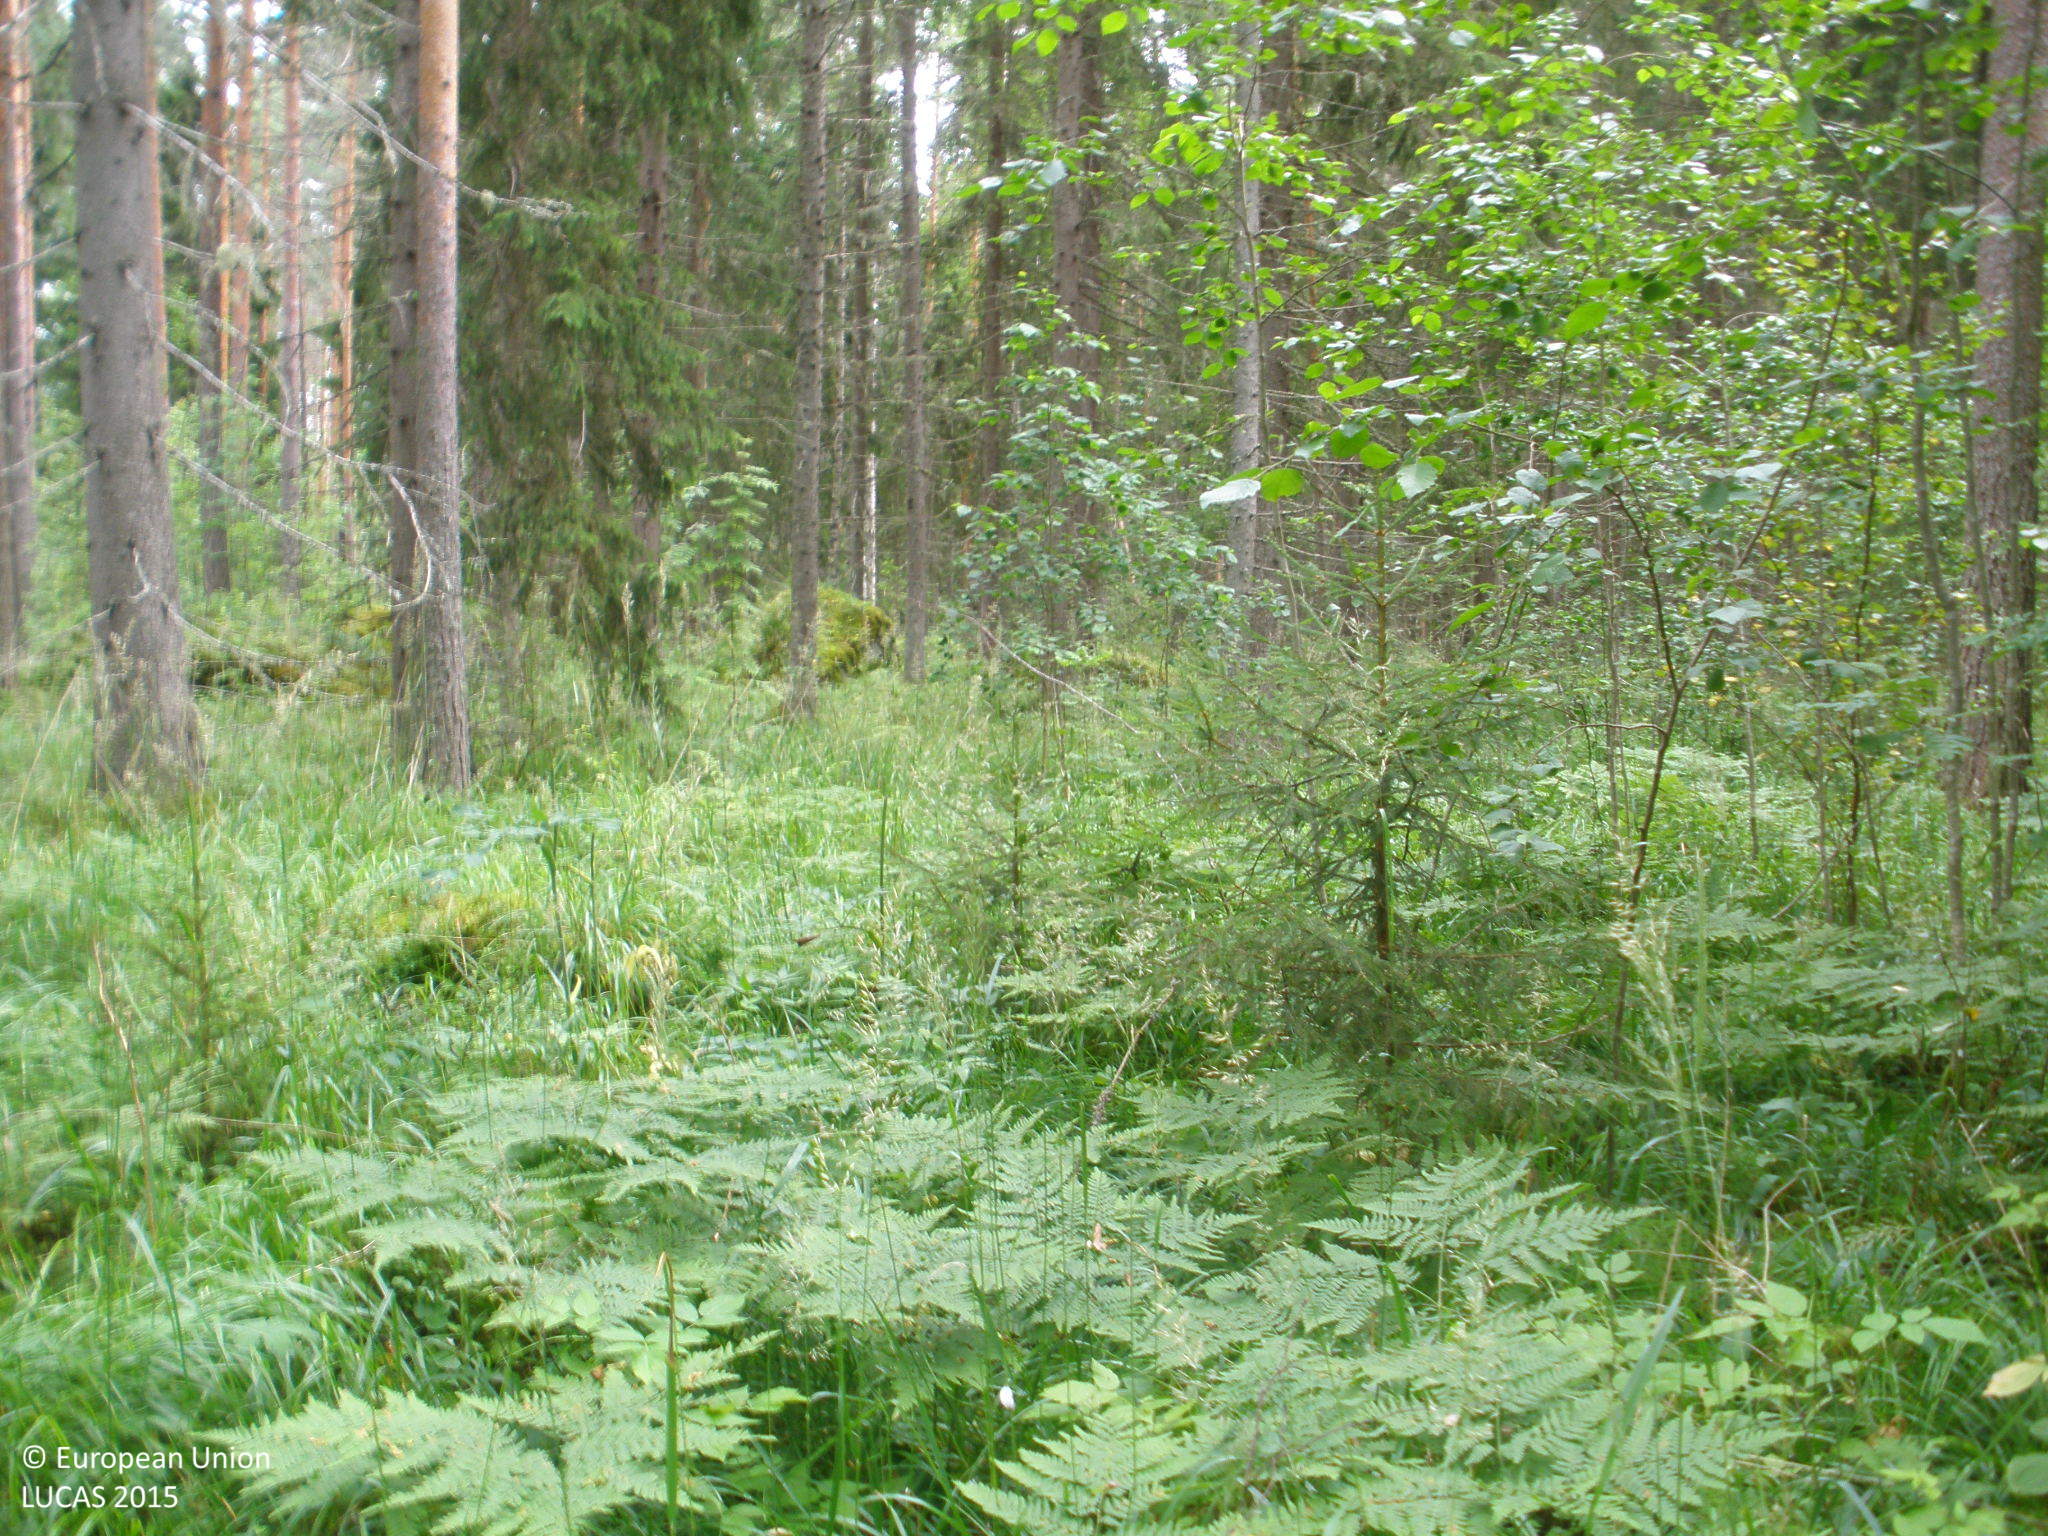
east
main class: Woodland
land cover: Spruce dominated mixed woodland
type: boreal forest
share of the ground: > 75 %
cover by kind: coniferous forest trees 60 %, broadleaved forest trees 25 %, herbaceous plants 10 %, lichens and mosses 5 %
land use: Forestry
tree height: > 5 m
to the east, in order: Spruce dominated mixed woodland; Pine dominated mixed woodland; Spruce dominated mixed woodland; Inland marshes; Inland fresh water bodies; Inland marshes; Pine dominated mixed woodland
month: July
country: FI
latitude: 61.3686
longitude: 24.7151
